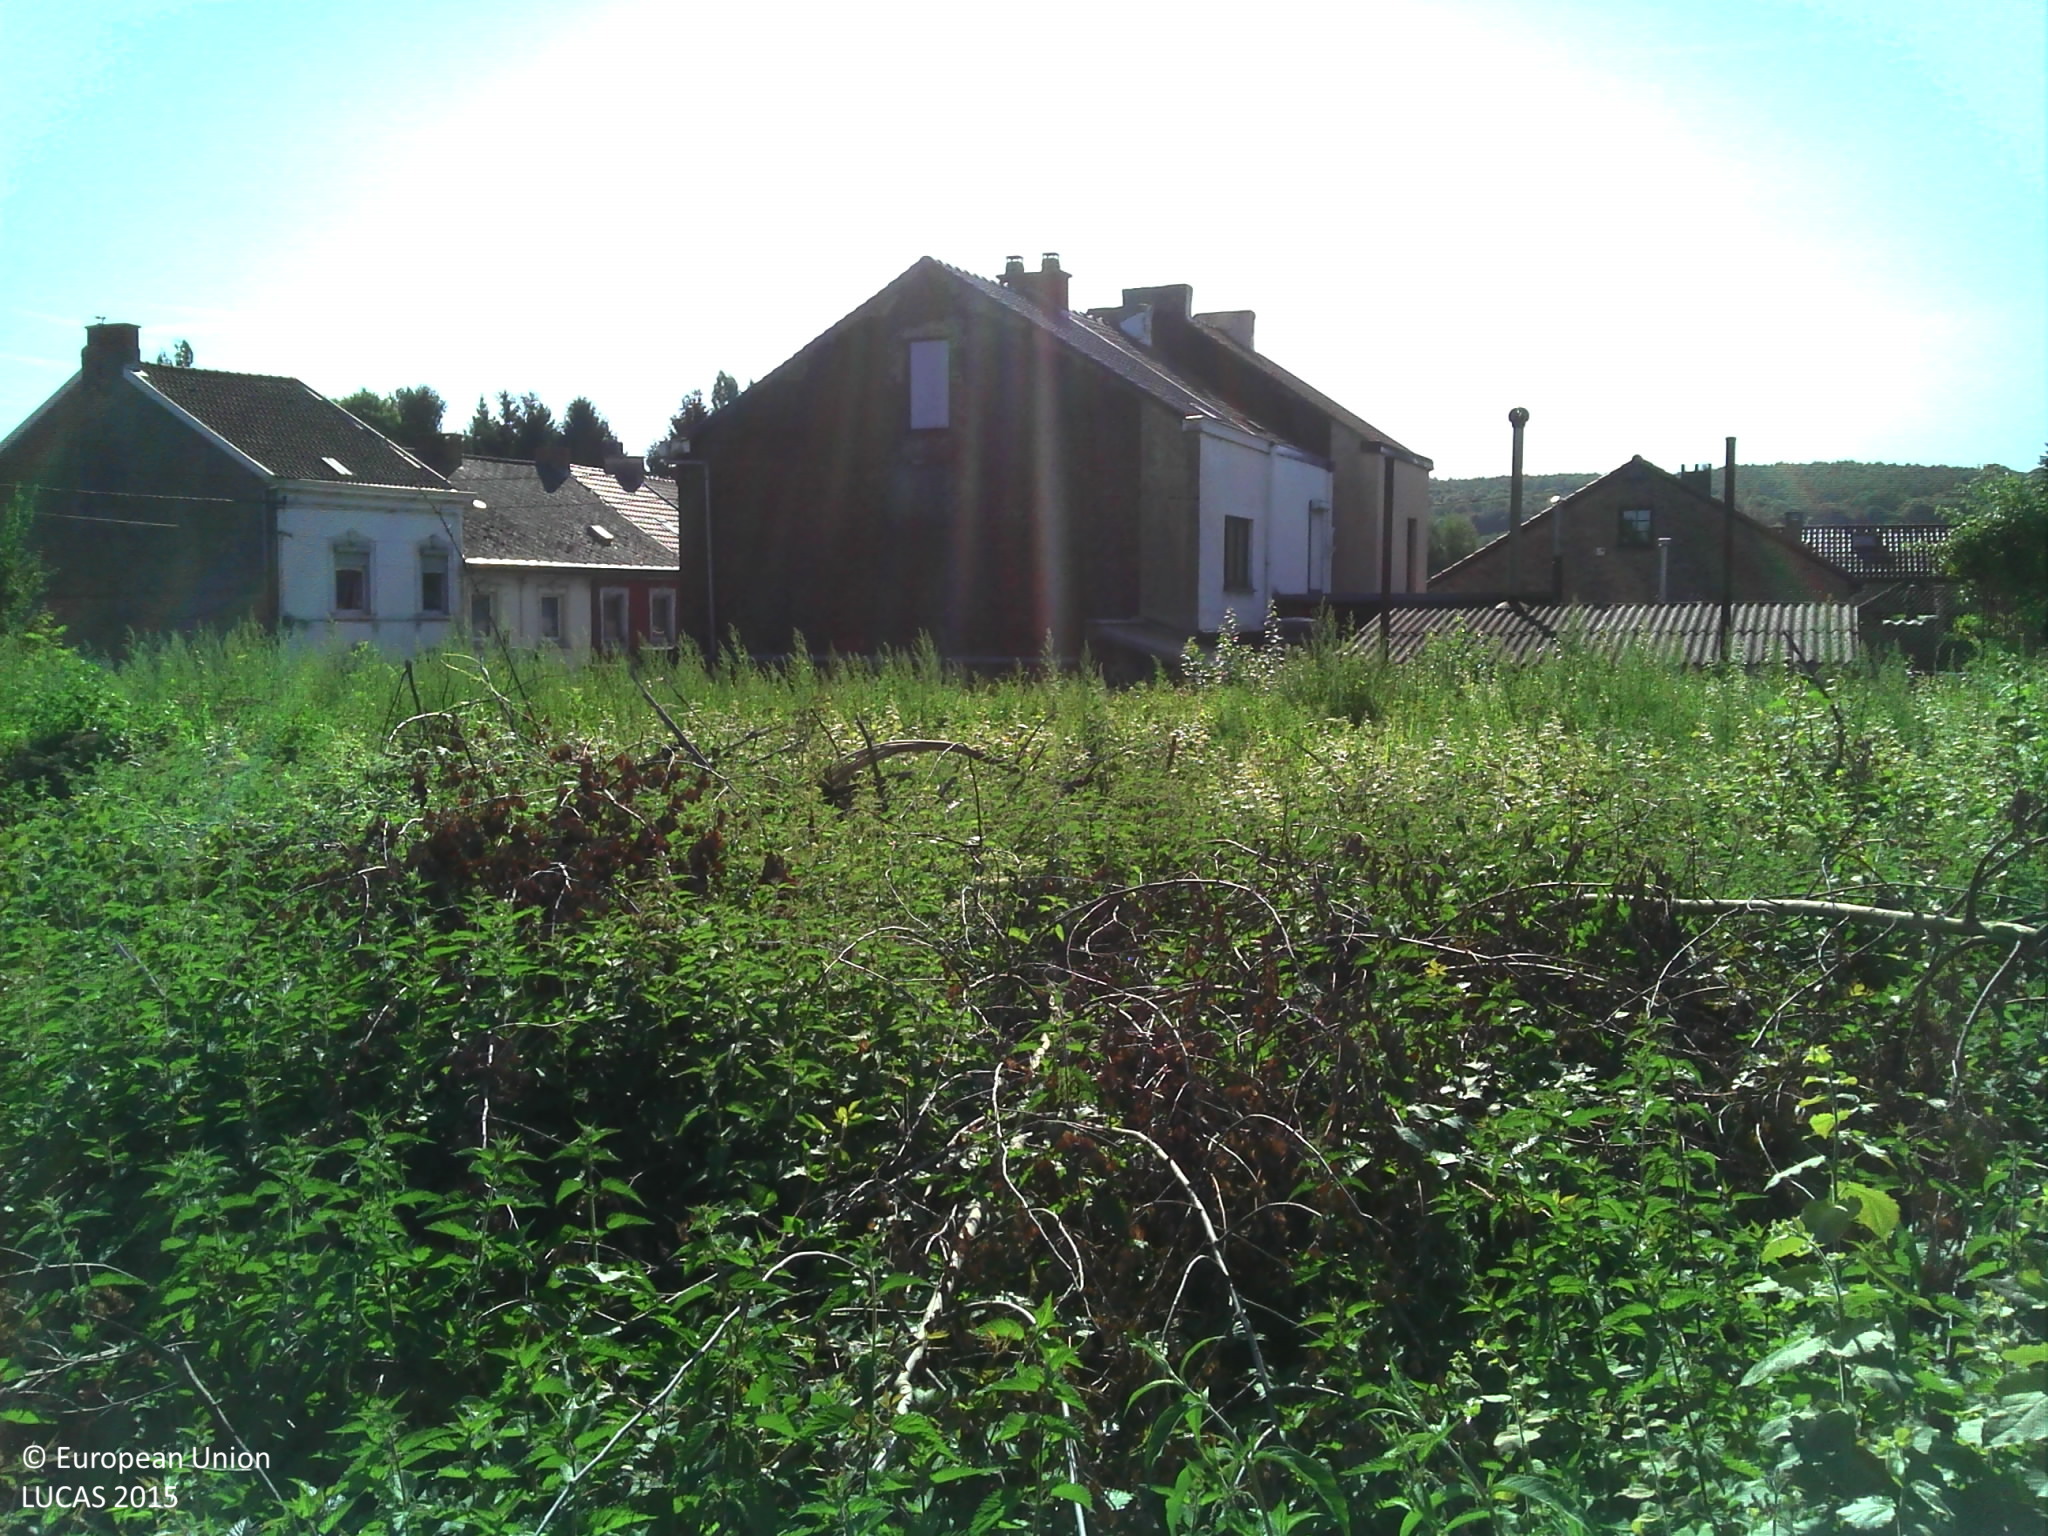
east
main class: Grassland
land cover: Spontaneously vegetated surfaces
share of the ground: > 75 %
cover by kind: herbaceous plants 95 %, shrubs 5 %
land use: Semi-natural and natural areas not in use
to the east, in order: Spontaneously vegetated surfaces; Artificial constructions in urban areas; Grassland without tree/shrub cover; Fences; Broadleaved woodland; Fences; Broadleaved woodland; Shrubland with sparse tree cover; Broadleaved woodland
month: August
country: BE
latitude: 50.4144
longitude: 4.5498
